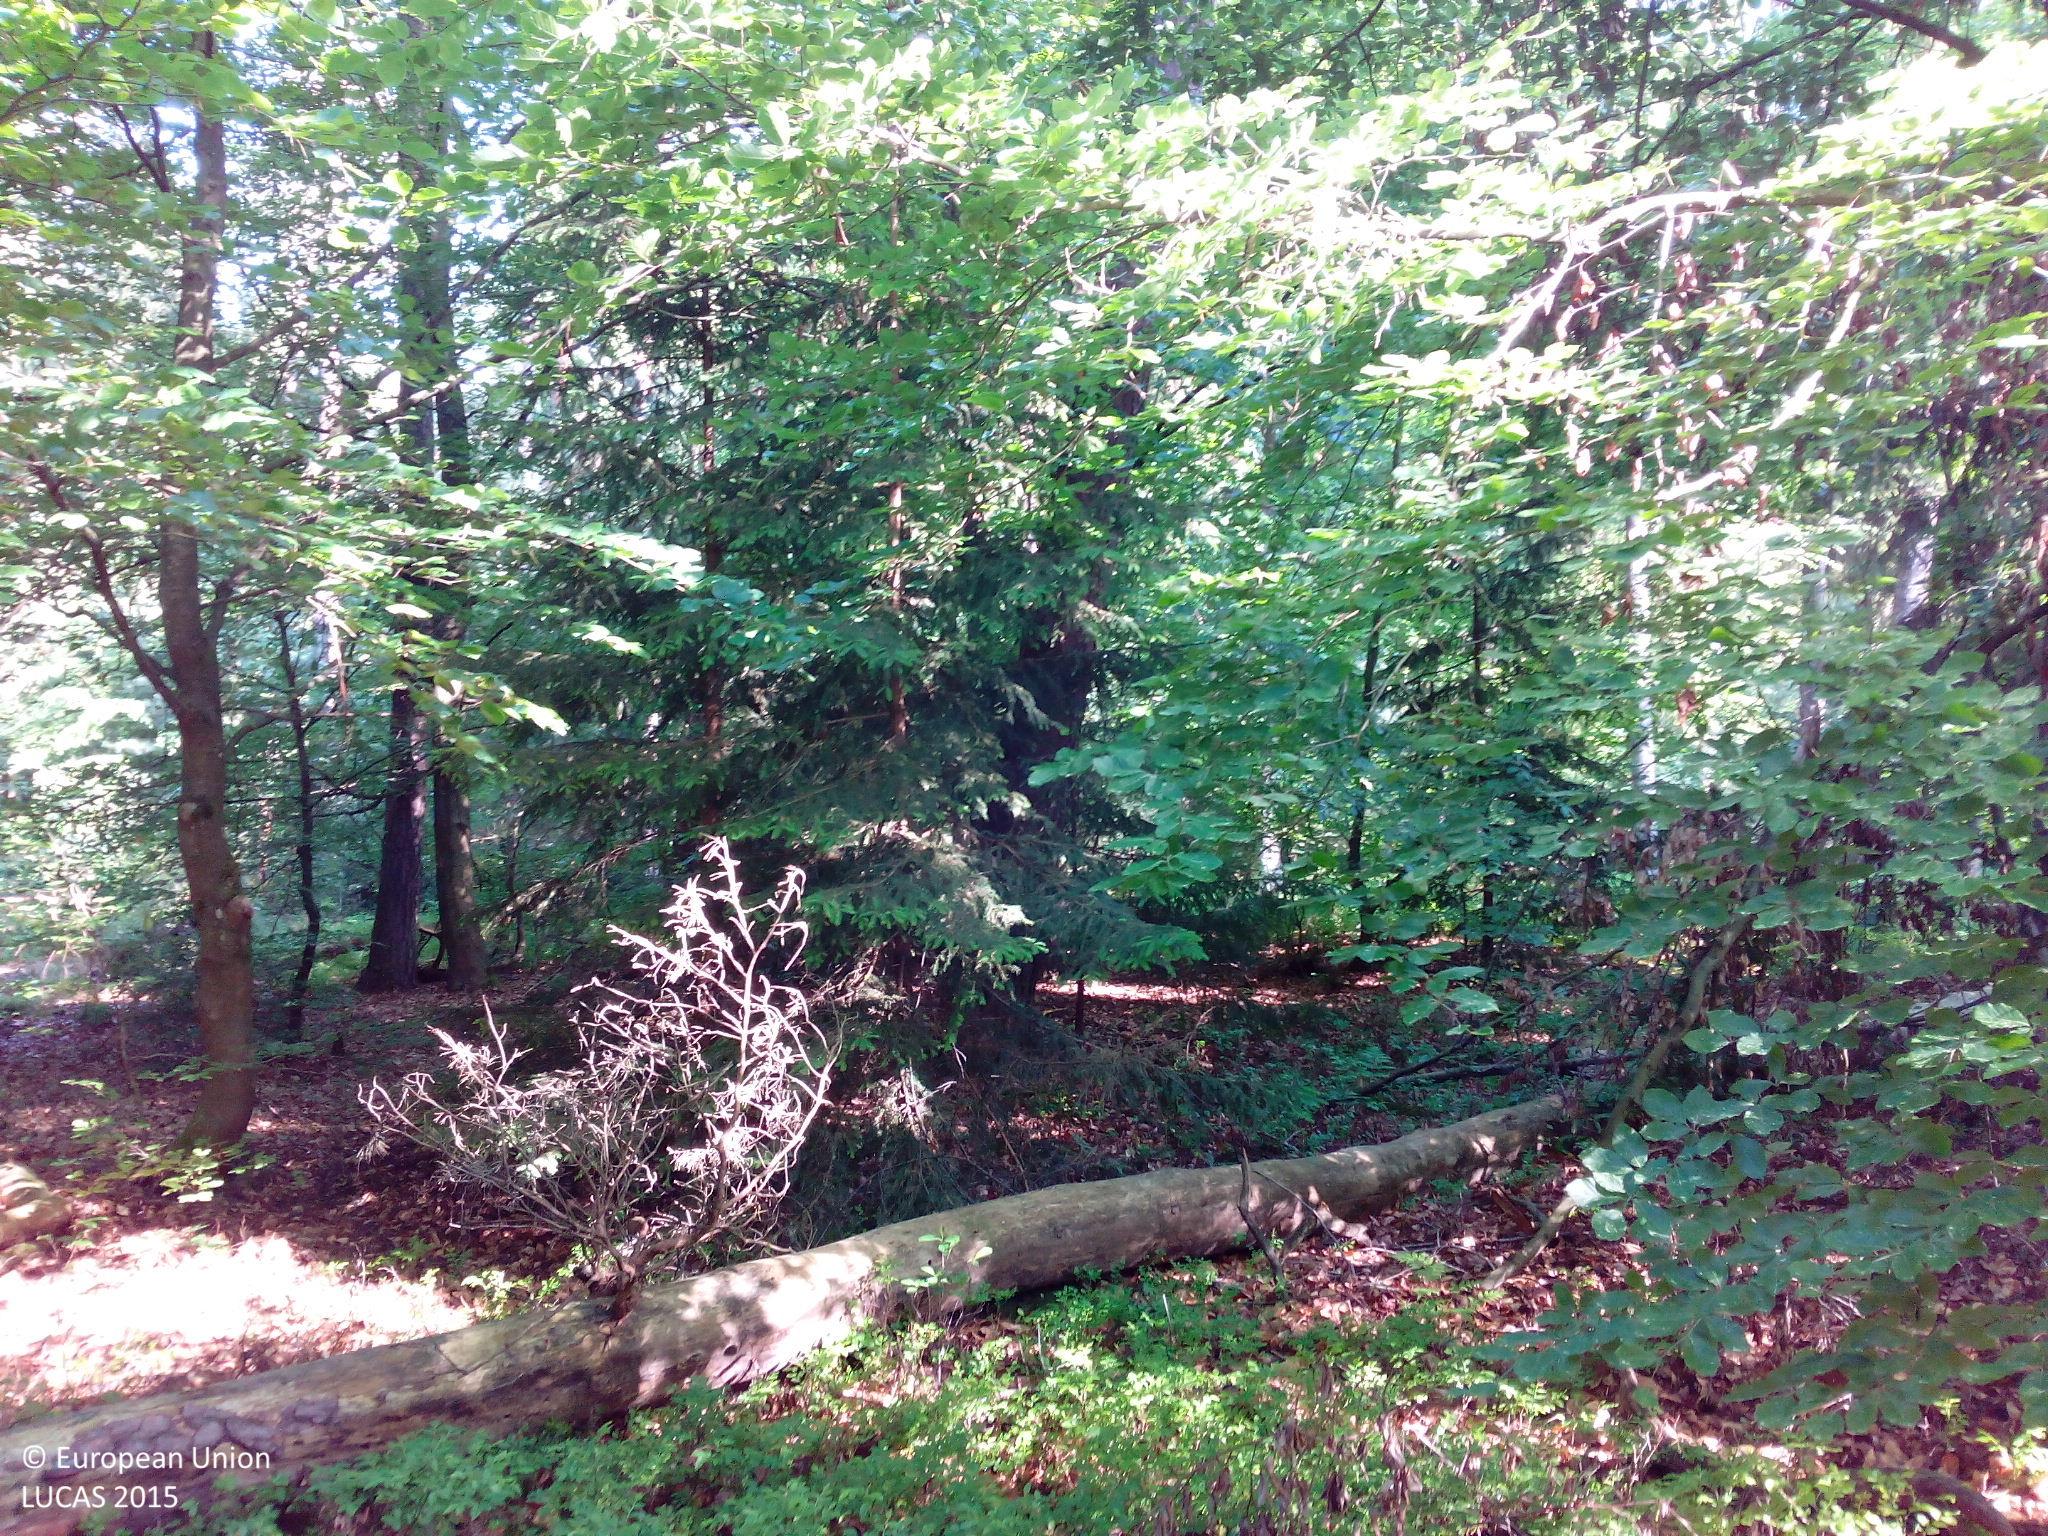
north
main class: Woodland
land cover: Other mixed woodland
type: hemiboreal forest and nemoral coniferous forest and mixed broadleaved-coniferous forest
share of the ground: > 75 %
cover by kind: broadleaved forest trees 60 %, coniferous forest trees 20 %, shrubs 10 %, herbaceous plants 5 %, unconsolidated bare surface 5 %
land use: Forestry
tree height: > 5 m
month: May
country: DE
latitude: 49.0544
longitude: 8.1807
